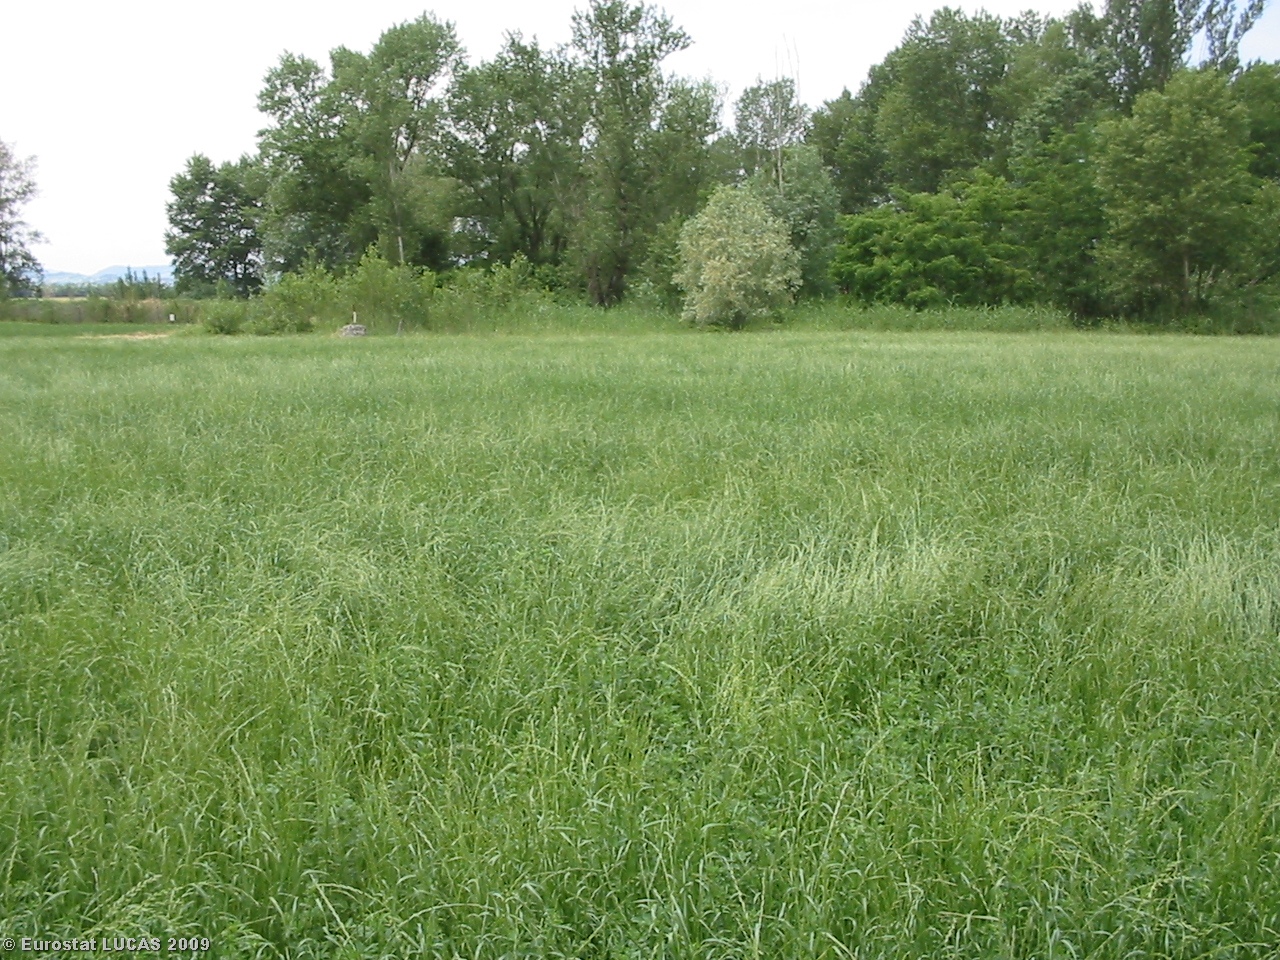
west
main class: Cropland
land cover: Lucerne
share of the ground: > 75 %
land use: Agriculture (excluding fallow land and kitchen gardens)
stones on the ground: < 10 %
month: June
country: IT
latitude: 44.7107
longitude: 10.3401
